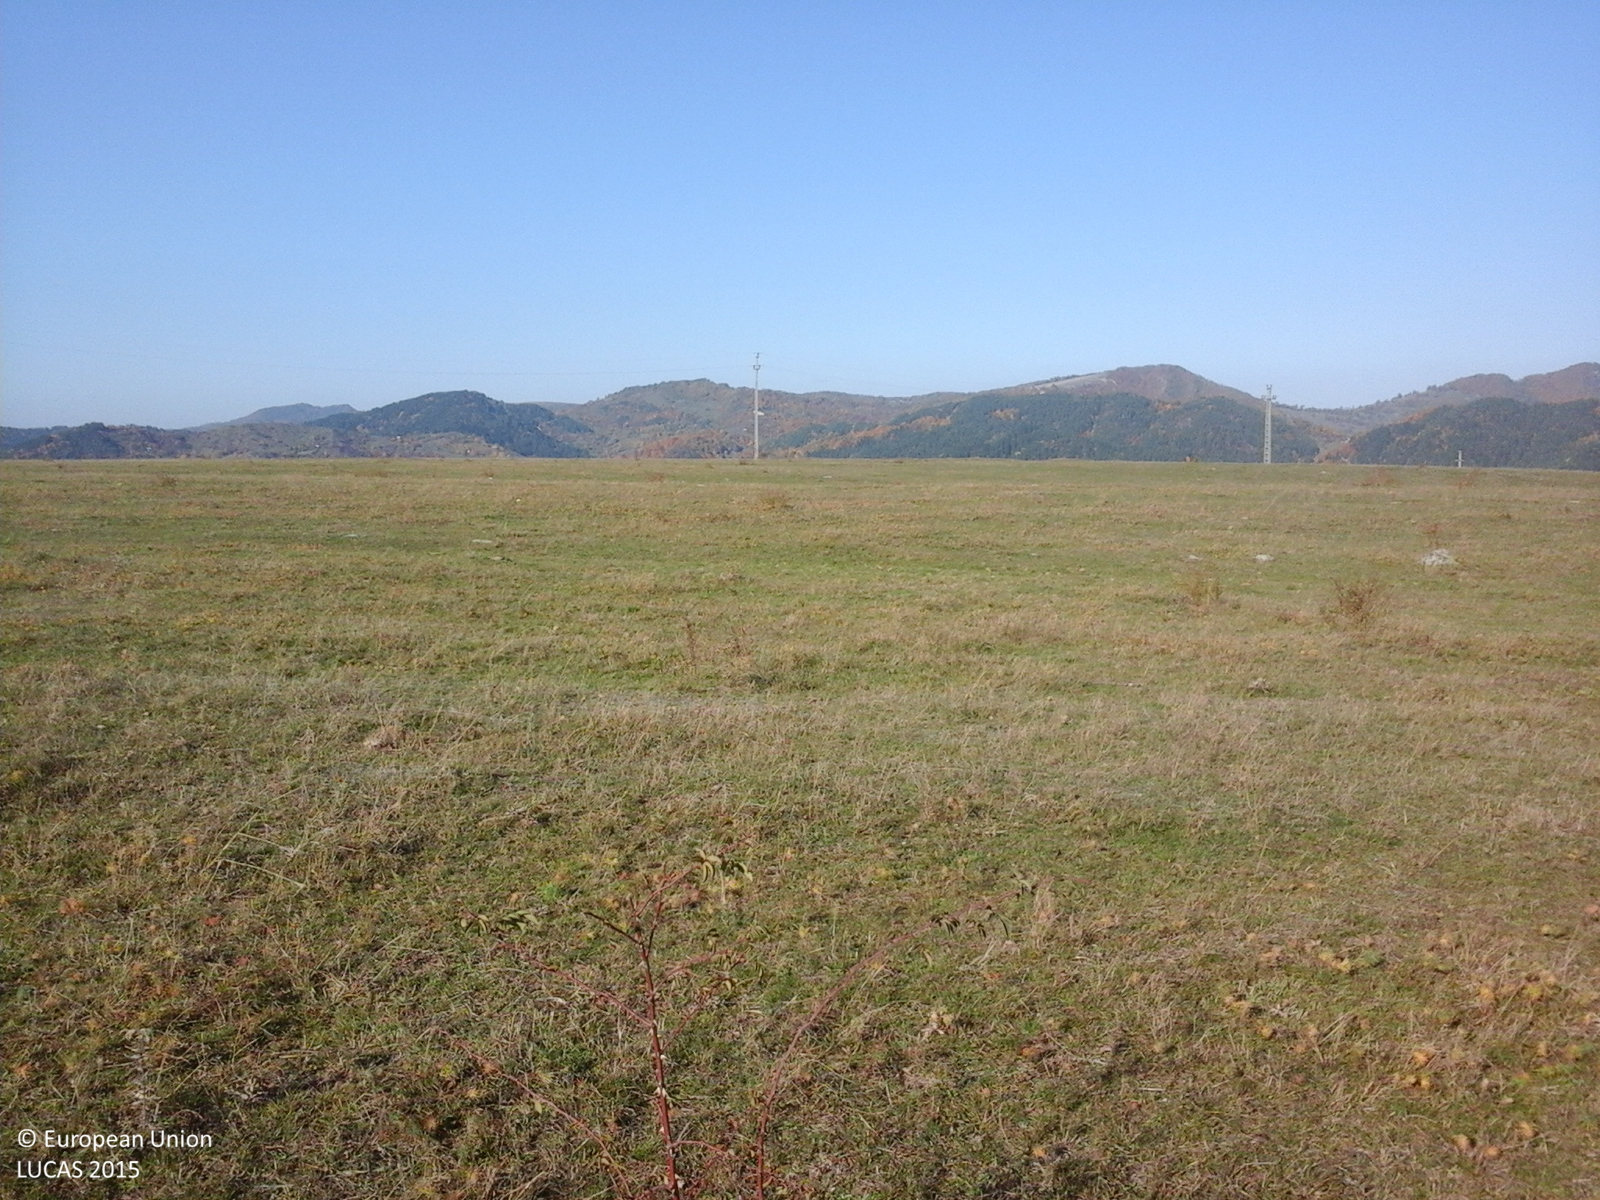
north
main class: Grassland
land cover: Grassland without tree/shrub cover
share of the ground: > 75 %
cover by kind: herbaceous plants 100 %
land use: Agriculture (excluding fallow land and kitchen gardens)
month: October
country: RO
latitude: 45.9046
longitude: 26.7250
